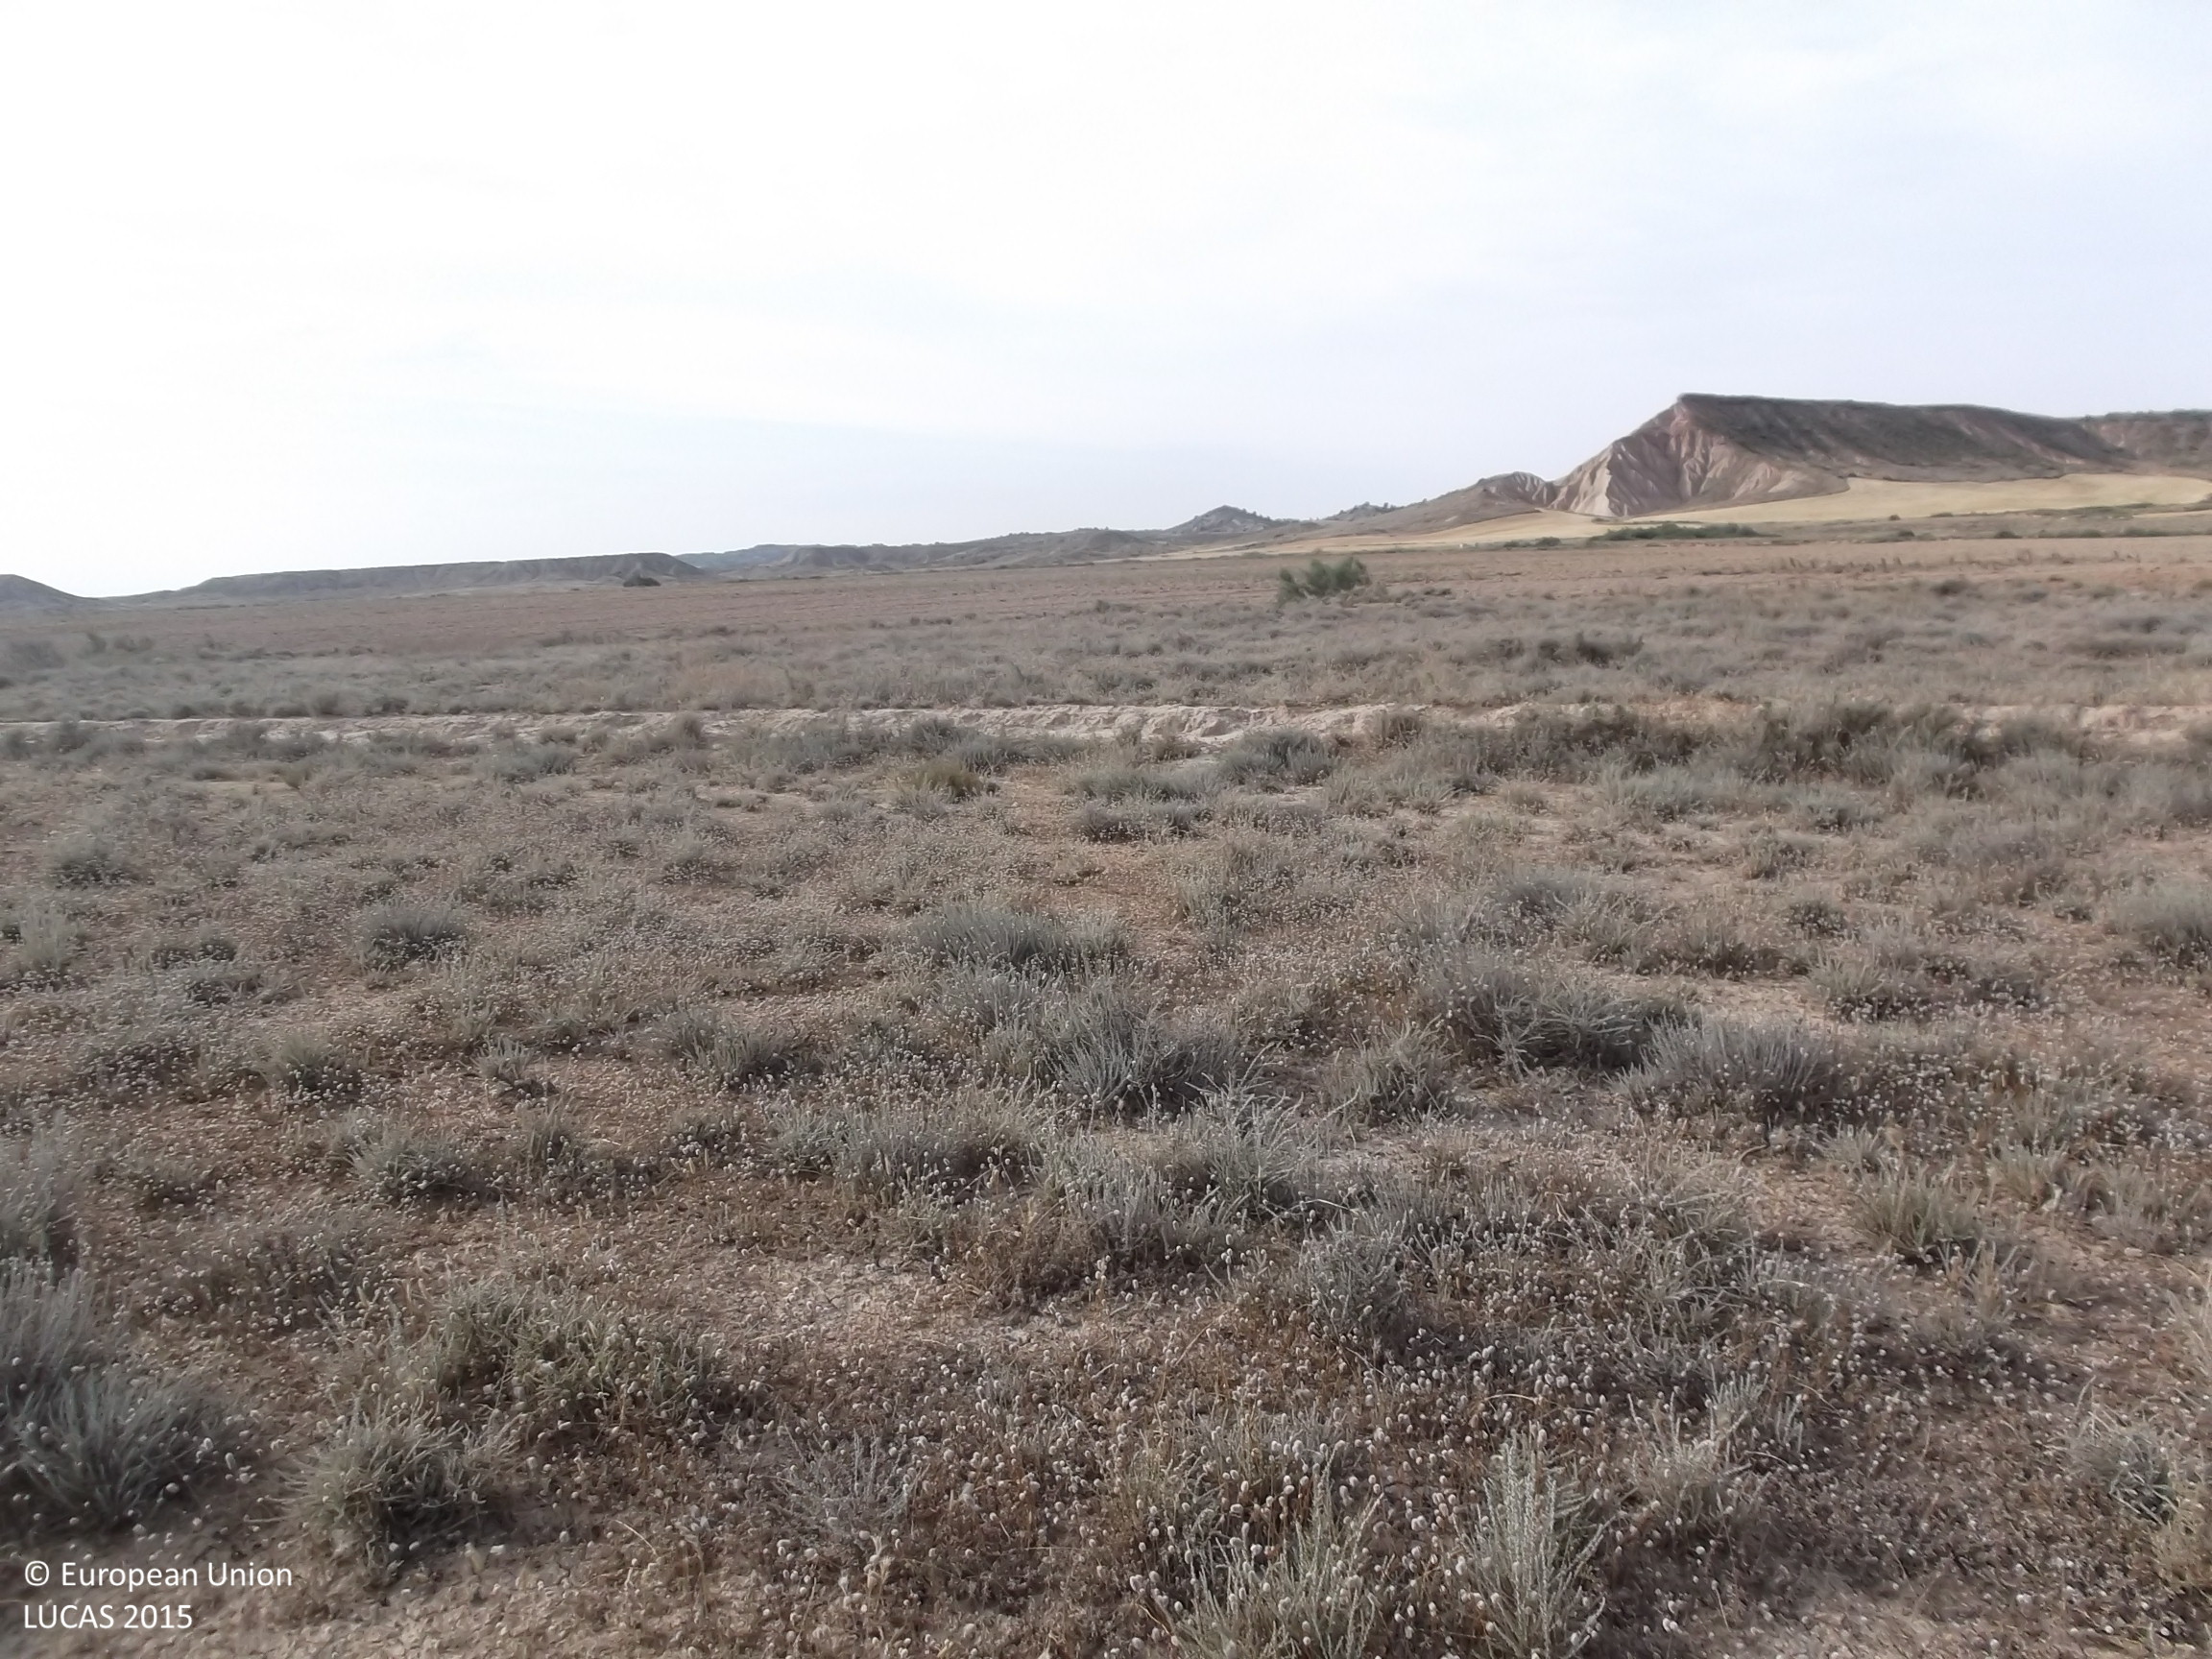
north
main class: Shrubland
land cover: Shrubland without tree cover
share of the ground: 50 - 75 %
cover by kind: shrubs 70 %, herbaceous plants 15 %, unconsolidated bare surface 10 %
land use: Semi-natural and natural areas not in use
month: July
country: ES
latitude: 42.2546
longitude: -1.6339
